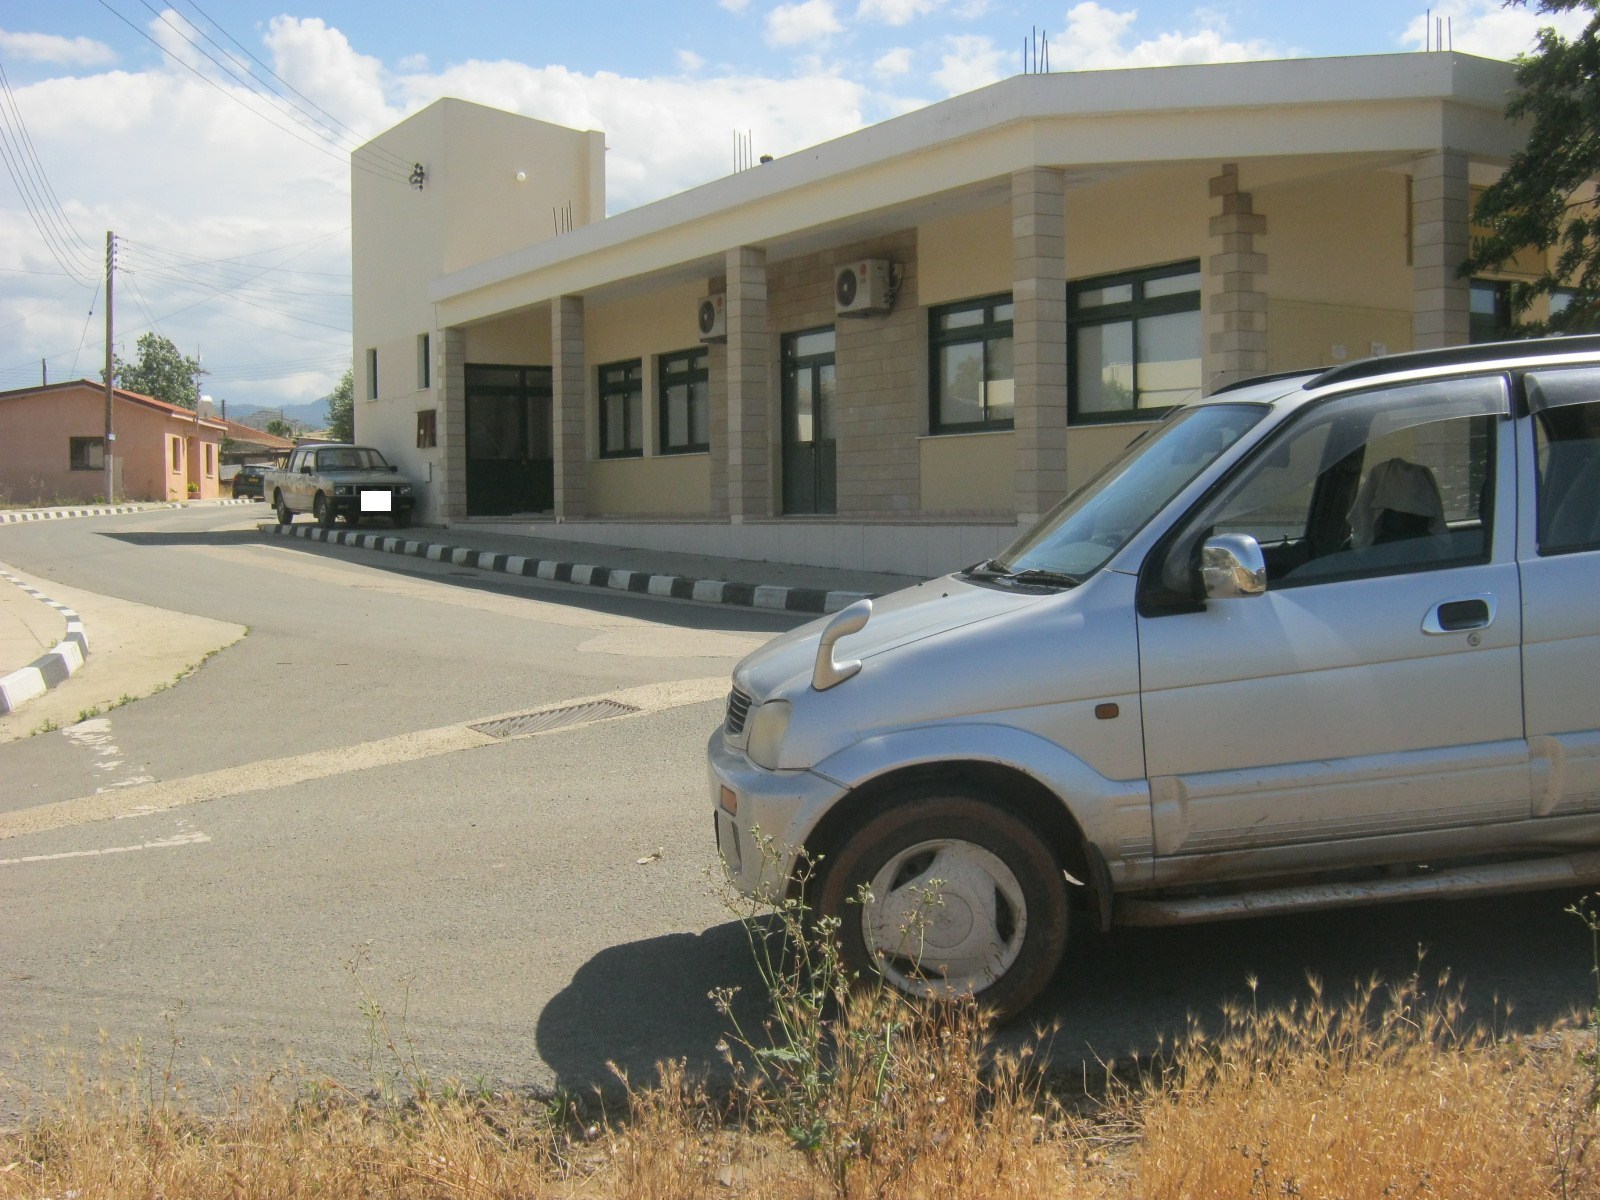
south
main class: Grassland
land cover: Grassland without tree/shrub cover
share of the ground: > 75 %
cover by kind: herbaceous plants 100 %
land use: Residential
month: May
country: CY
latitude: 35.1049
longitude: 33.0307
